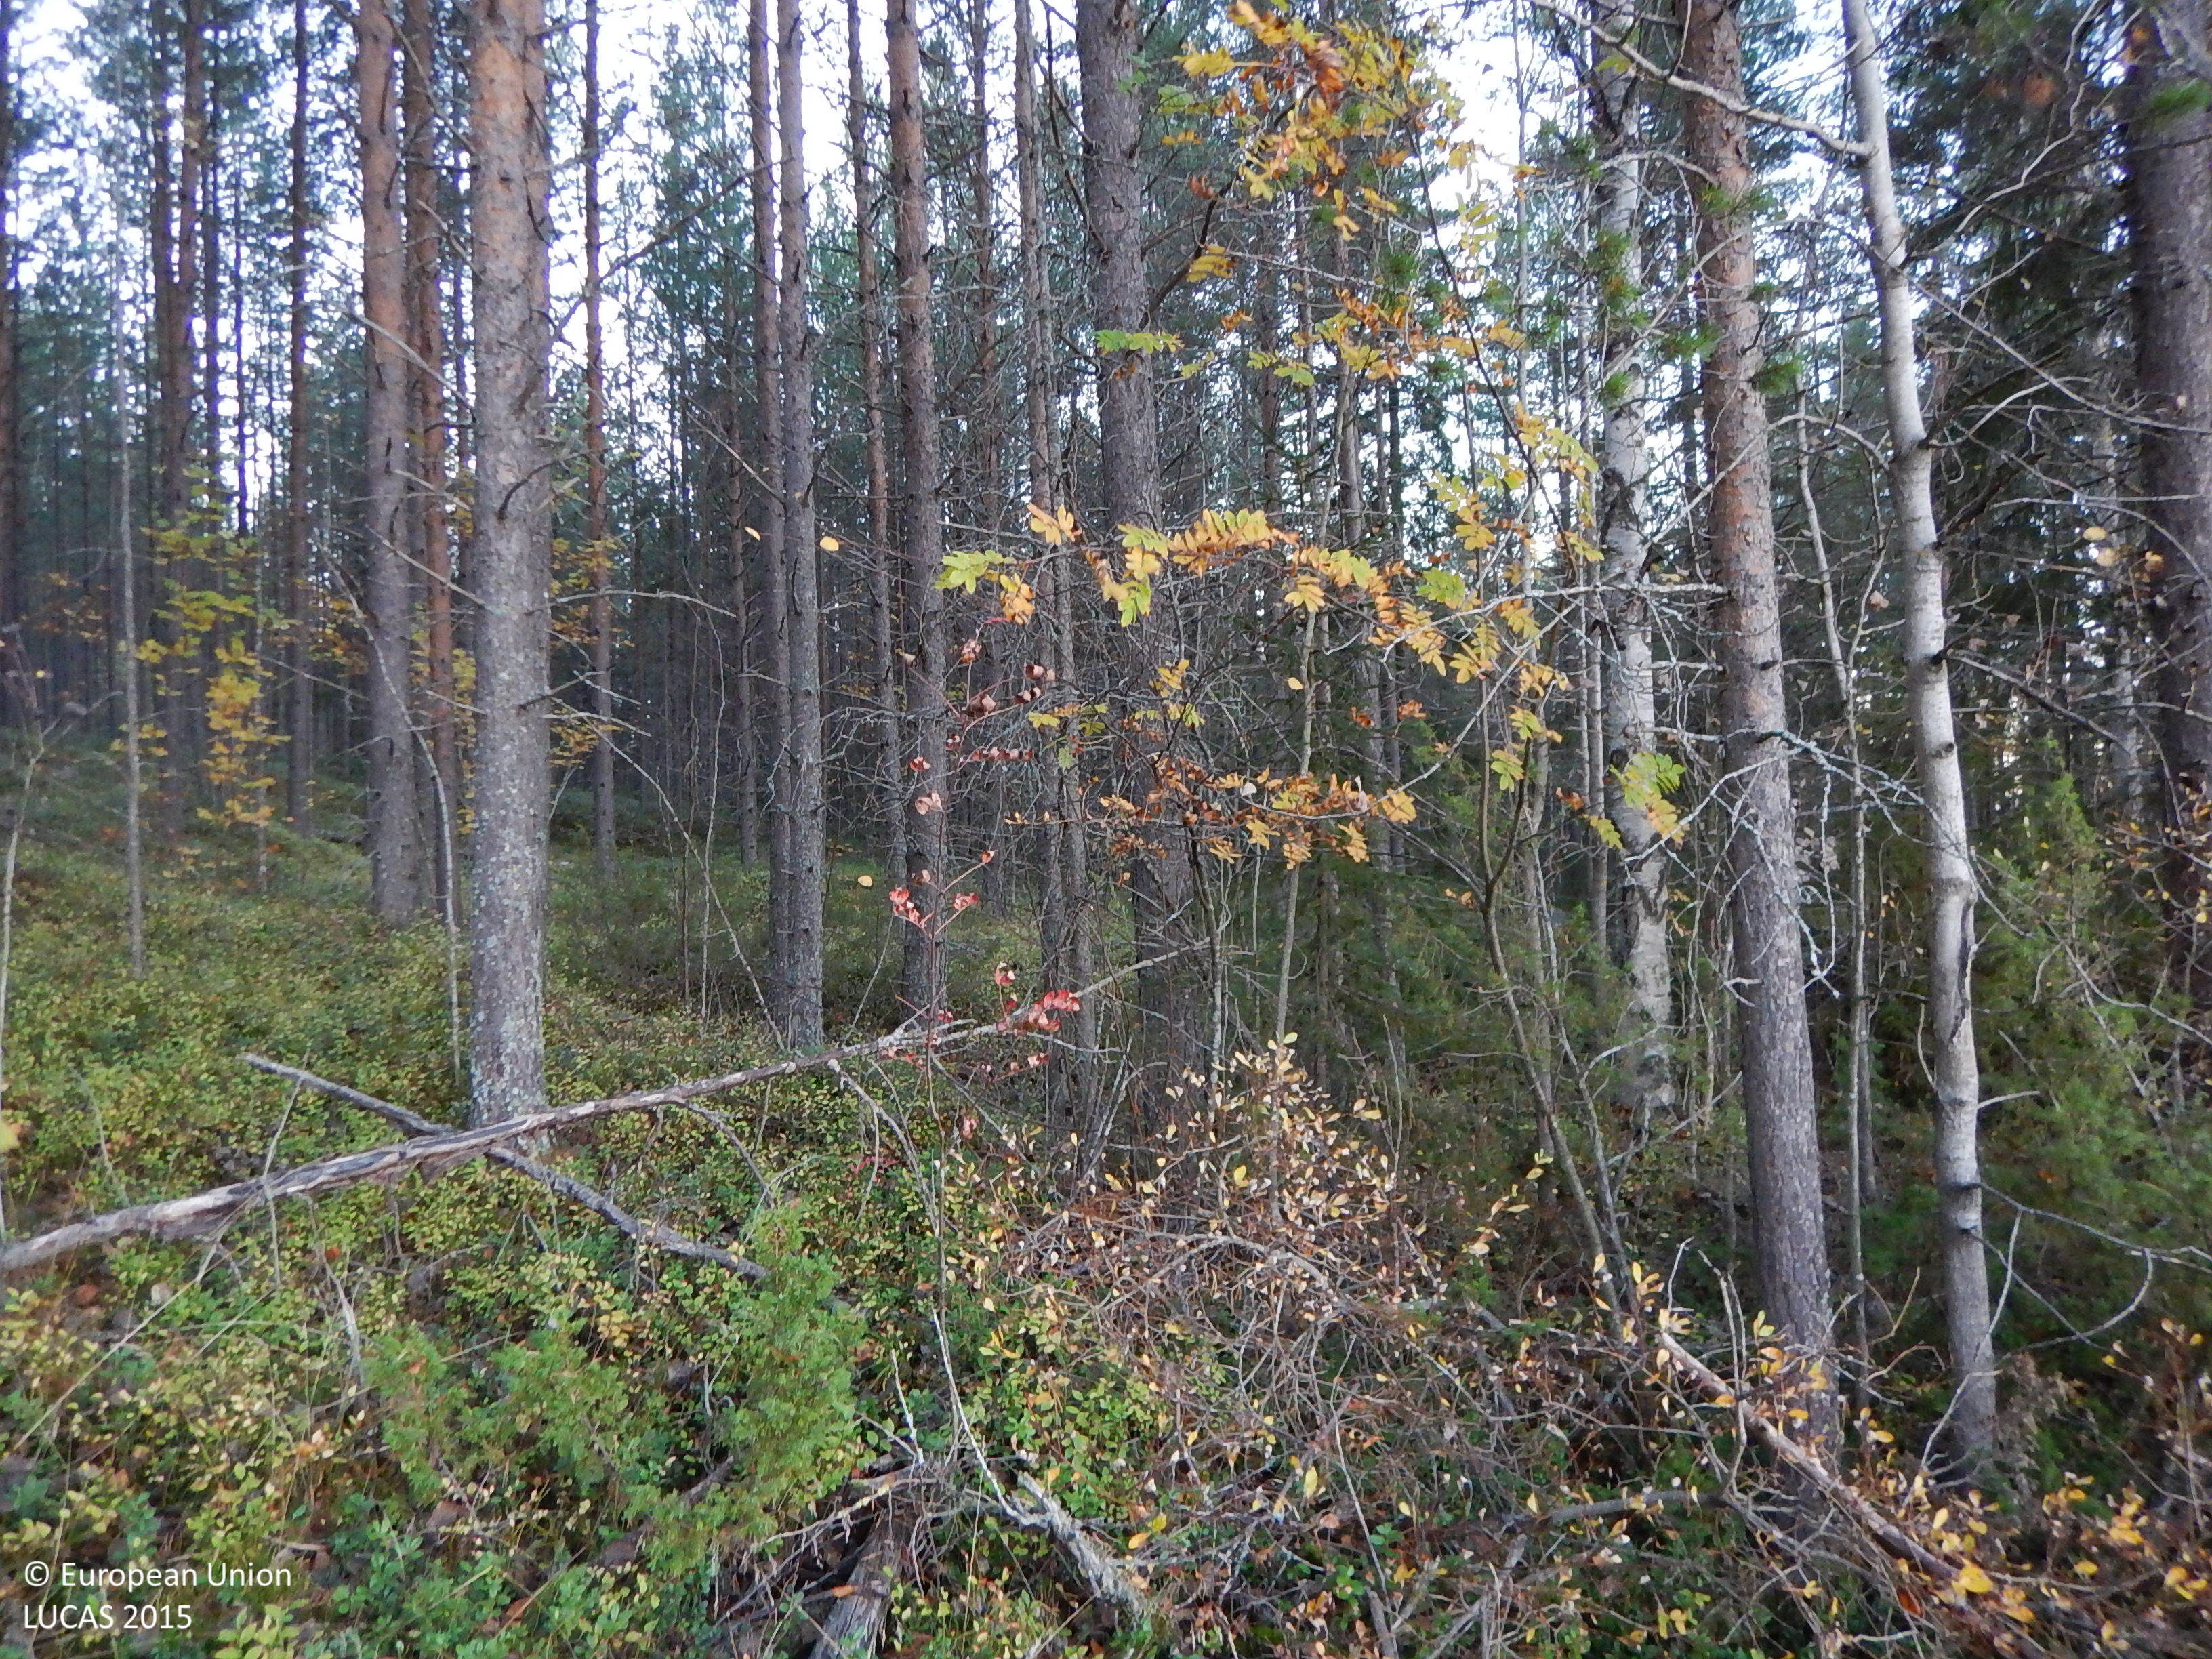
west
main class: Woodland
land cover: Pine dominated mixed woodland
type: boreal forest
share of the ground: 50 - 75 %
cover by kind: coniferous forest trees 40 %, broadleaved forest trees 20 %, shrubs 20 %, herbaceous plants 10 %, lichens and mosses 10 %
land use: Forestry
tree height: > 5 m
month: October
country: SE
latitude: 64.8876
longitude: 21.0643
